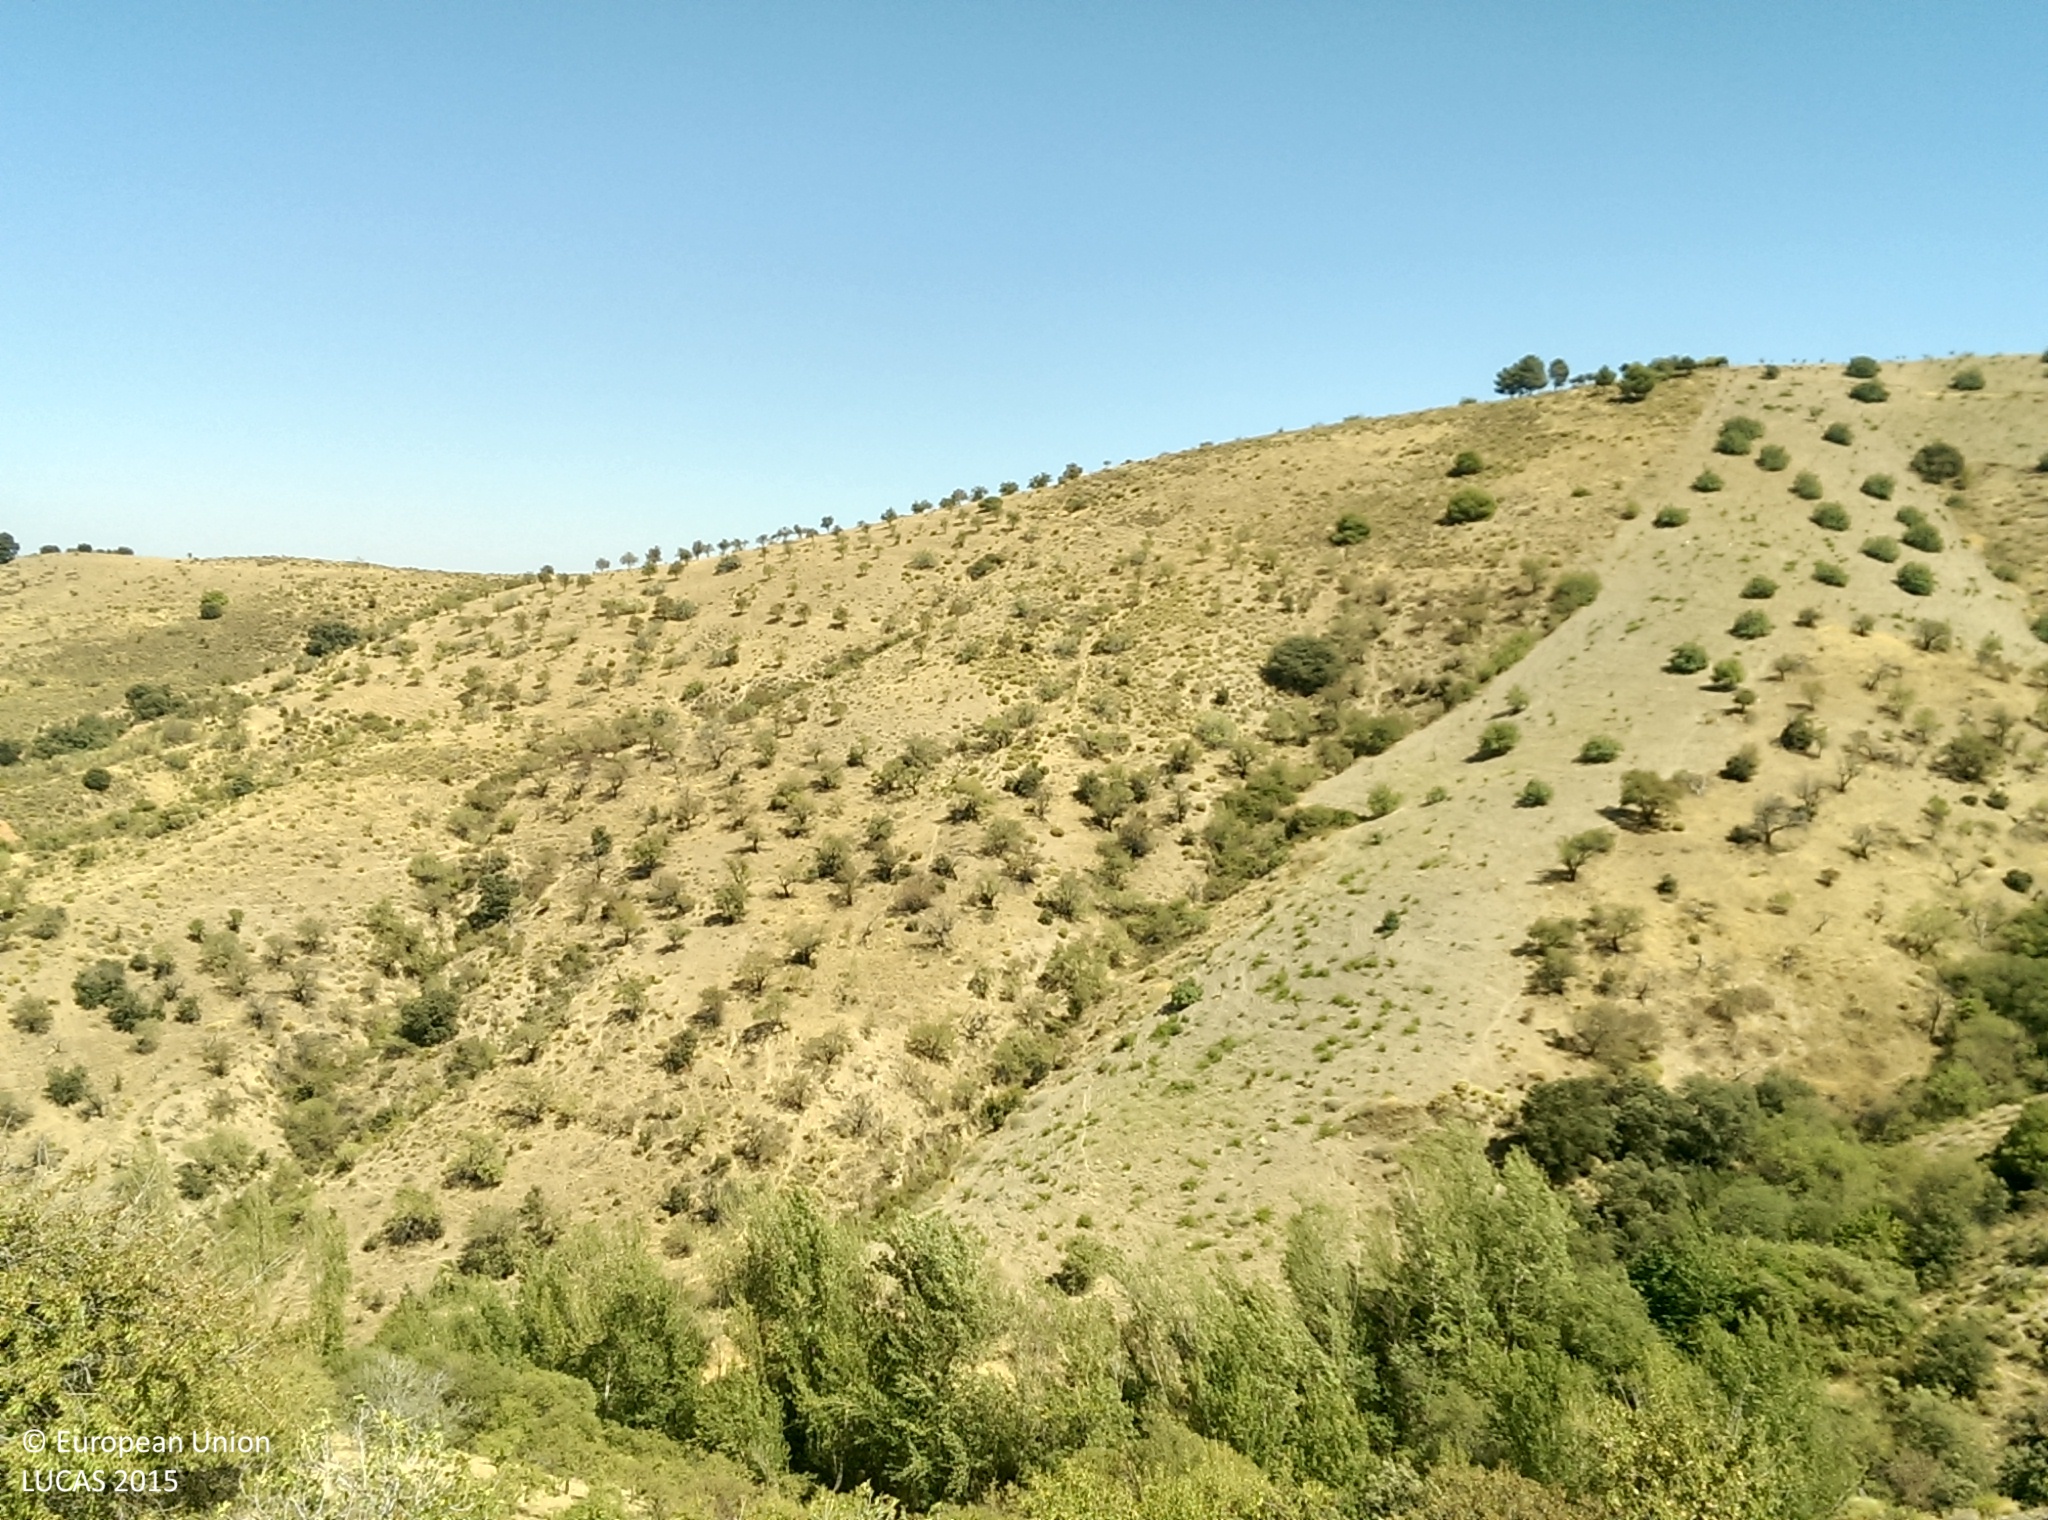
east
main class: Woodland
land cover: Broadleaved woodland
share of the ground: 25 - 50 %
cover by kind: broadleaved forest trees 40 %, herbaceous plants 30 %, shrubs 20 %, unconsolidated bare surface 10 %
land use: Semi-natural and natural areas not in use
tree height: > 5 m
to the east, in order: Broadleaved woodland; Rivers and streams; Broadleaved woodland; Nuts trees; Grassland without tree/shrub cover; Shrubland without tree cover; Nuts trees
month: August
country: ES
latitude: 36.8948
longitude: -3.2115
